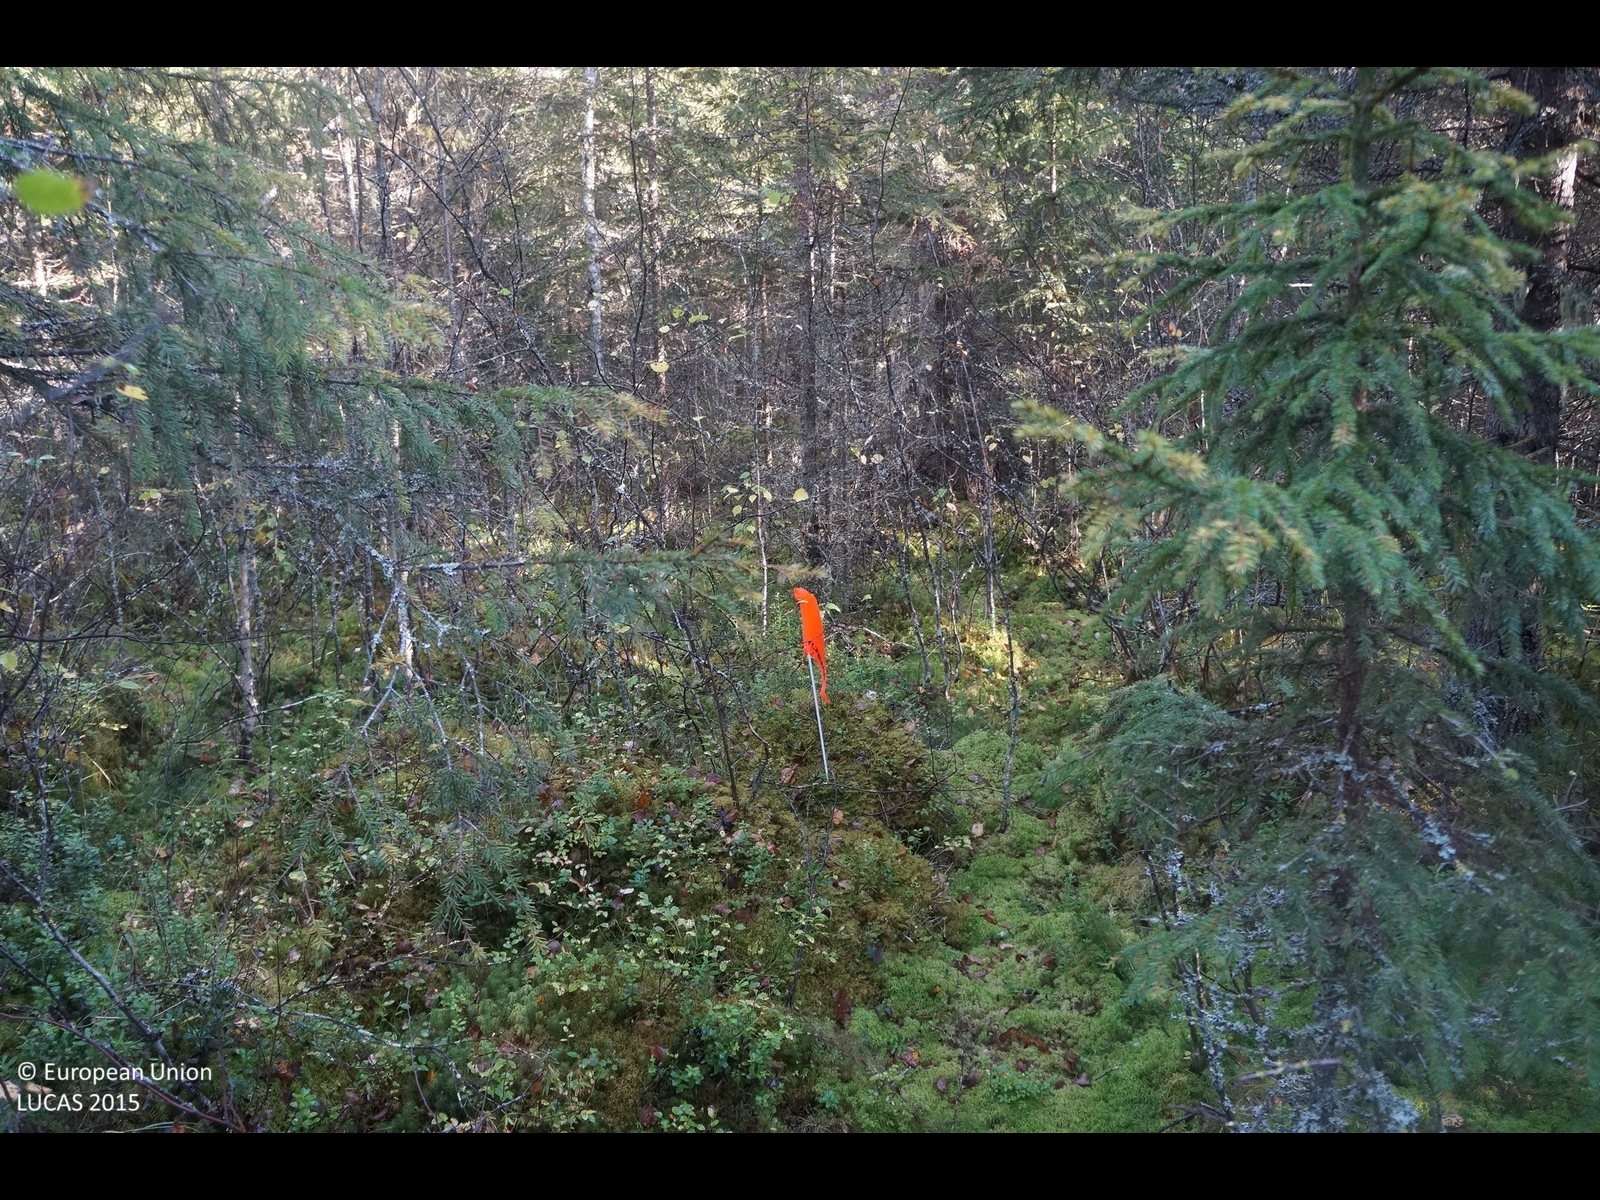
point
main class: Woodland
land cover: Spruce dominated mixed woodland
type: boreal forest
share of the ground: > 75 %
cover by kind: coniferous forest trees 55 %, broadleaved forest trees 20 %, lichens and mosses 15 %, shrubs 10 %
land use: Forestry
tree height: > 5 m
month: September
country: FI
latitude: 64.3369
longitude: 24.2846
